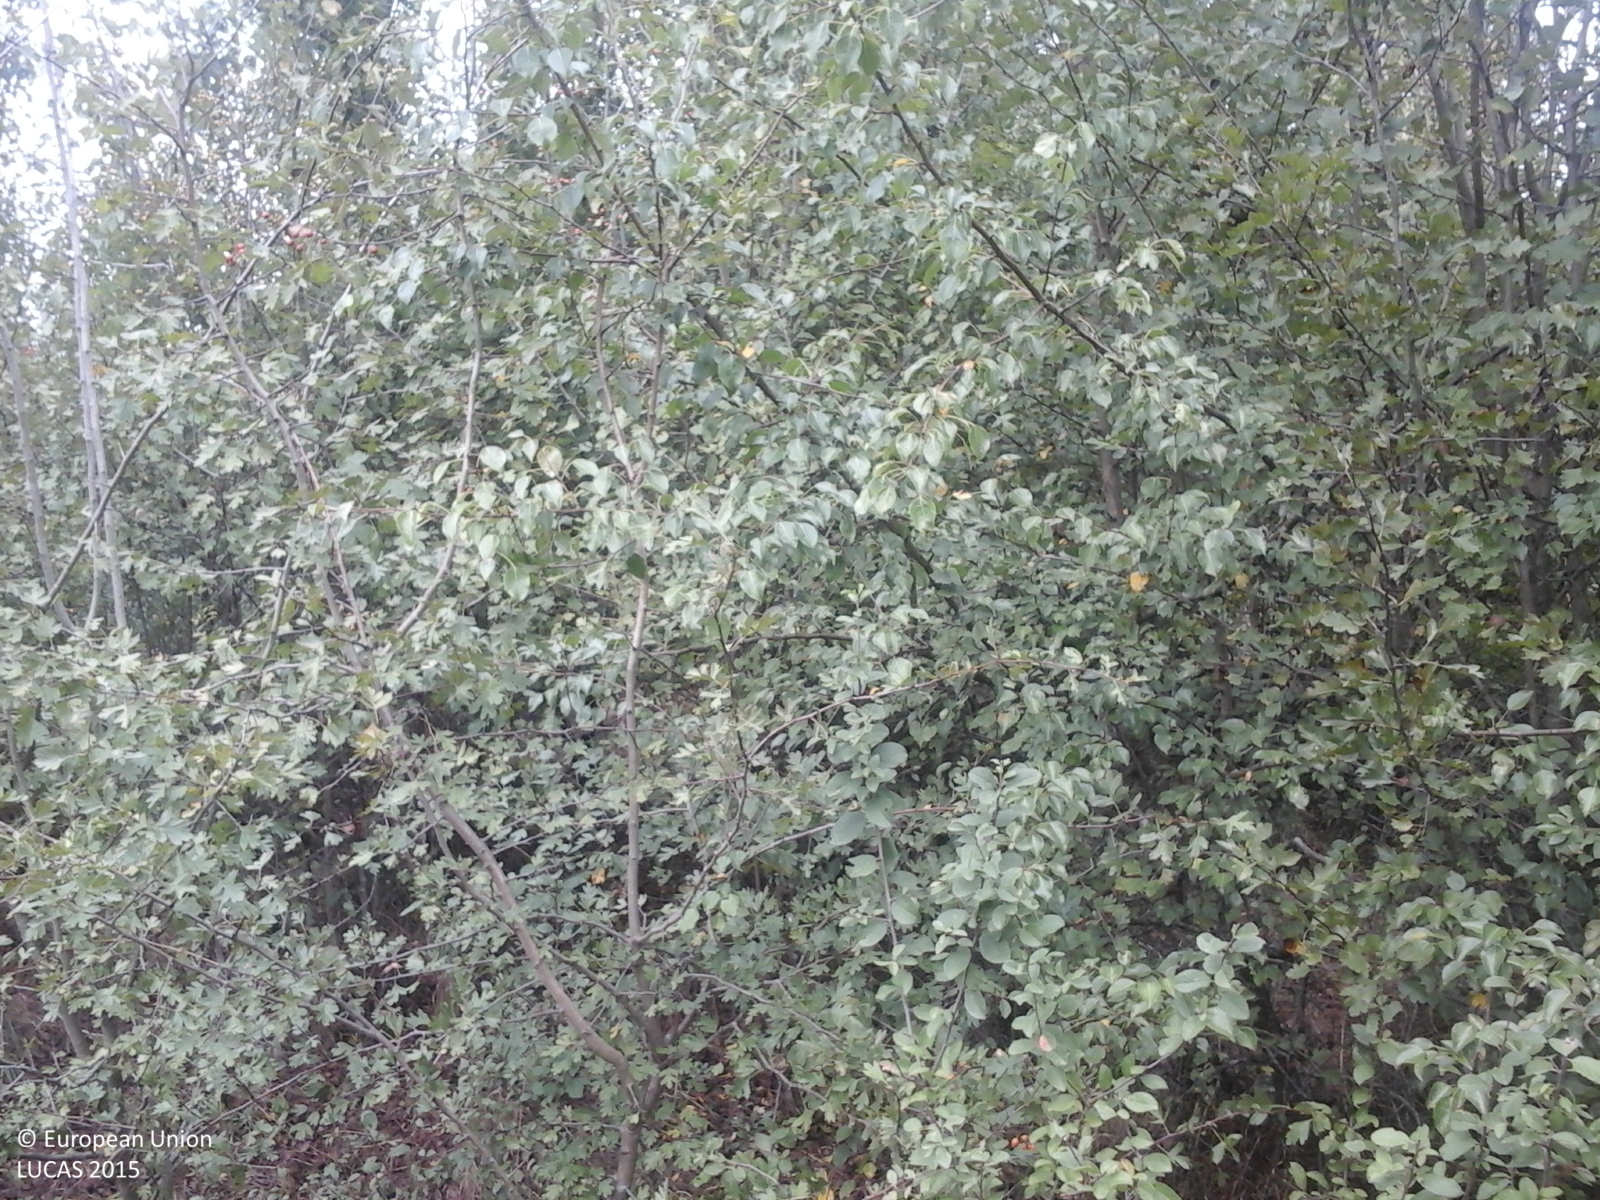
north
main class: Shrubland
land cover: Shrubland with sparse tree cover
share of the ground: > 75 %
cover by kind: herbaceous plants 70 %, shrubs 25 %, broadleaved forest trees 5 %
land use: Semi-natural and natural areas not in use
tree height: < 5 m
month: August
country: RO
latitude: 45.9121
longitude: 21.6522
